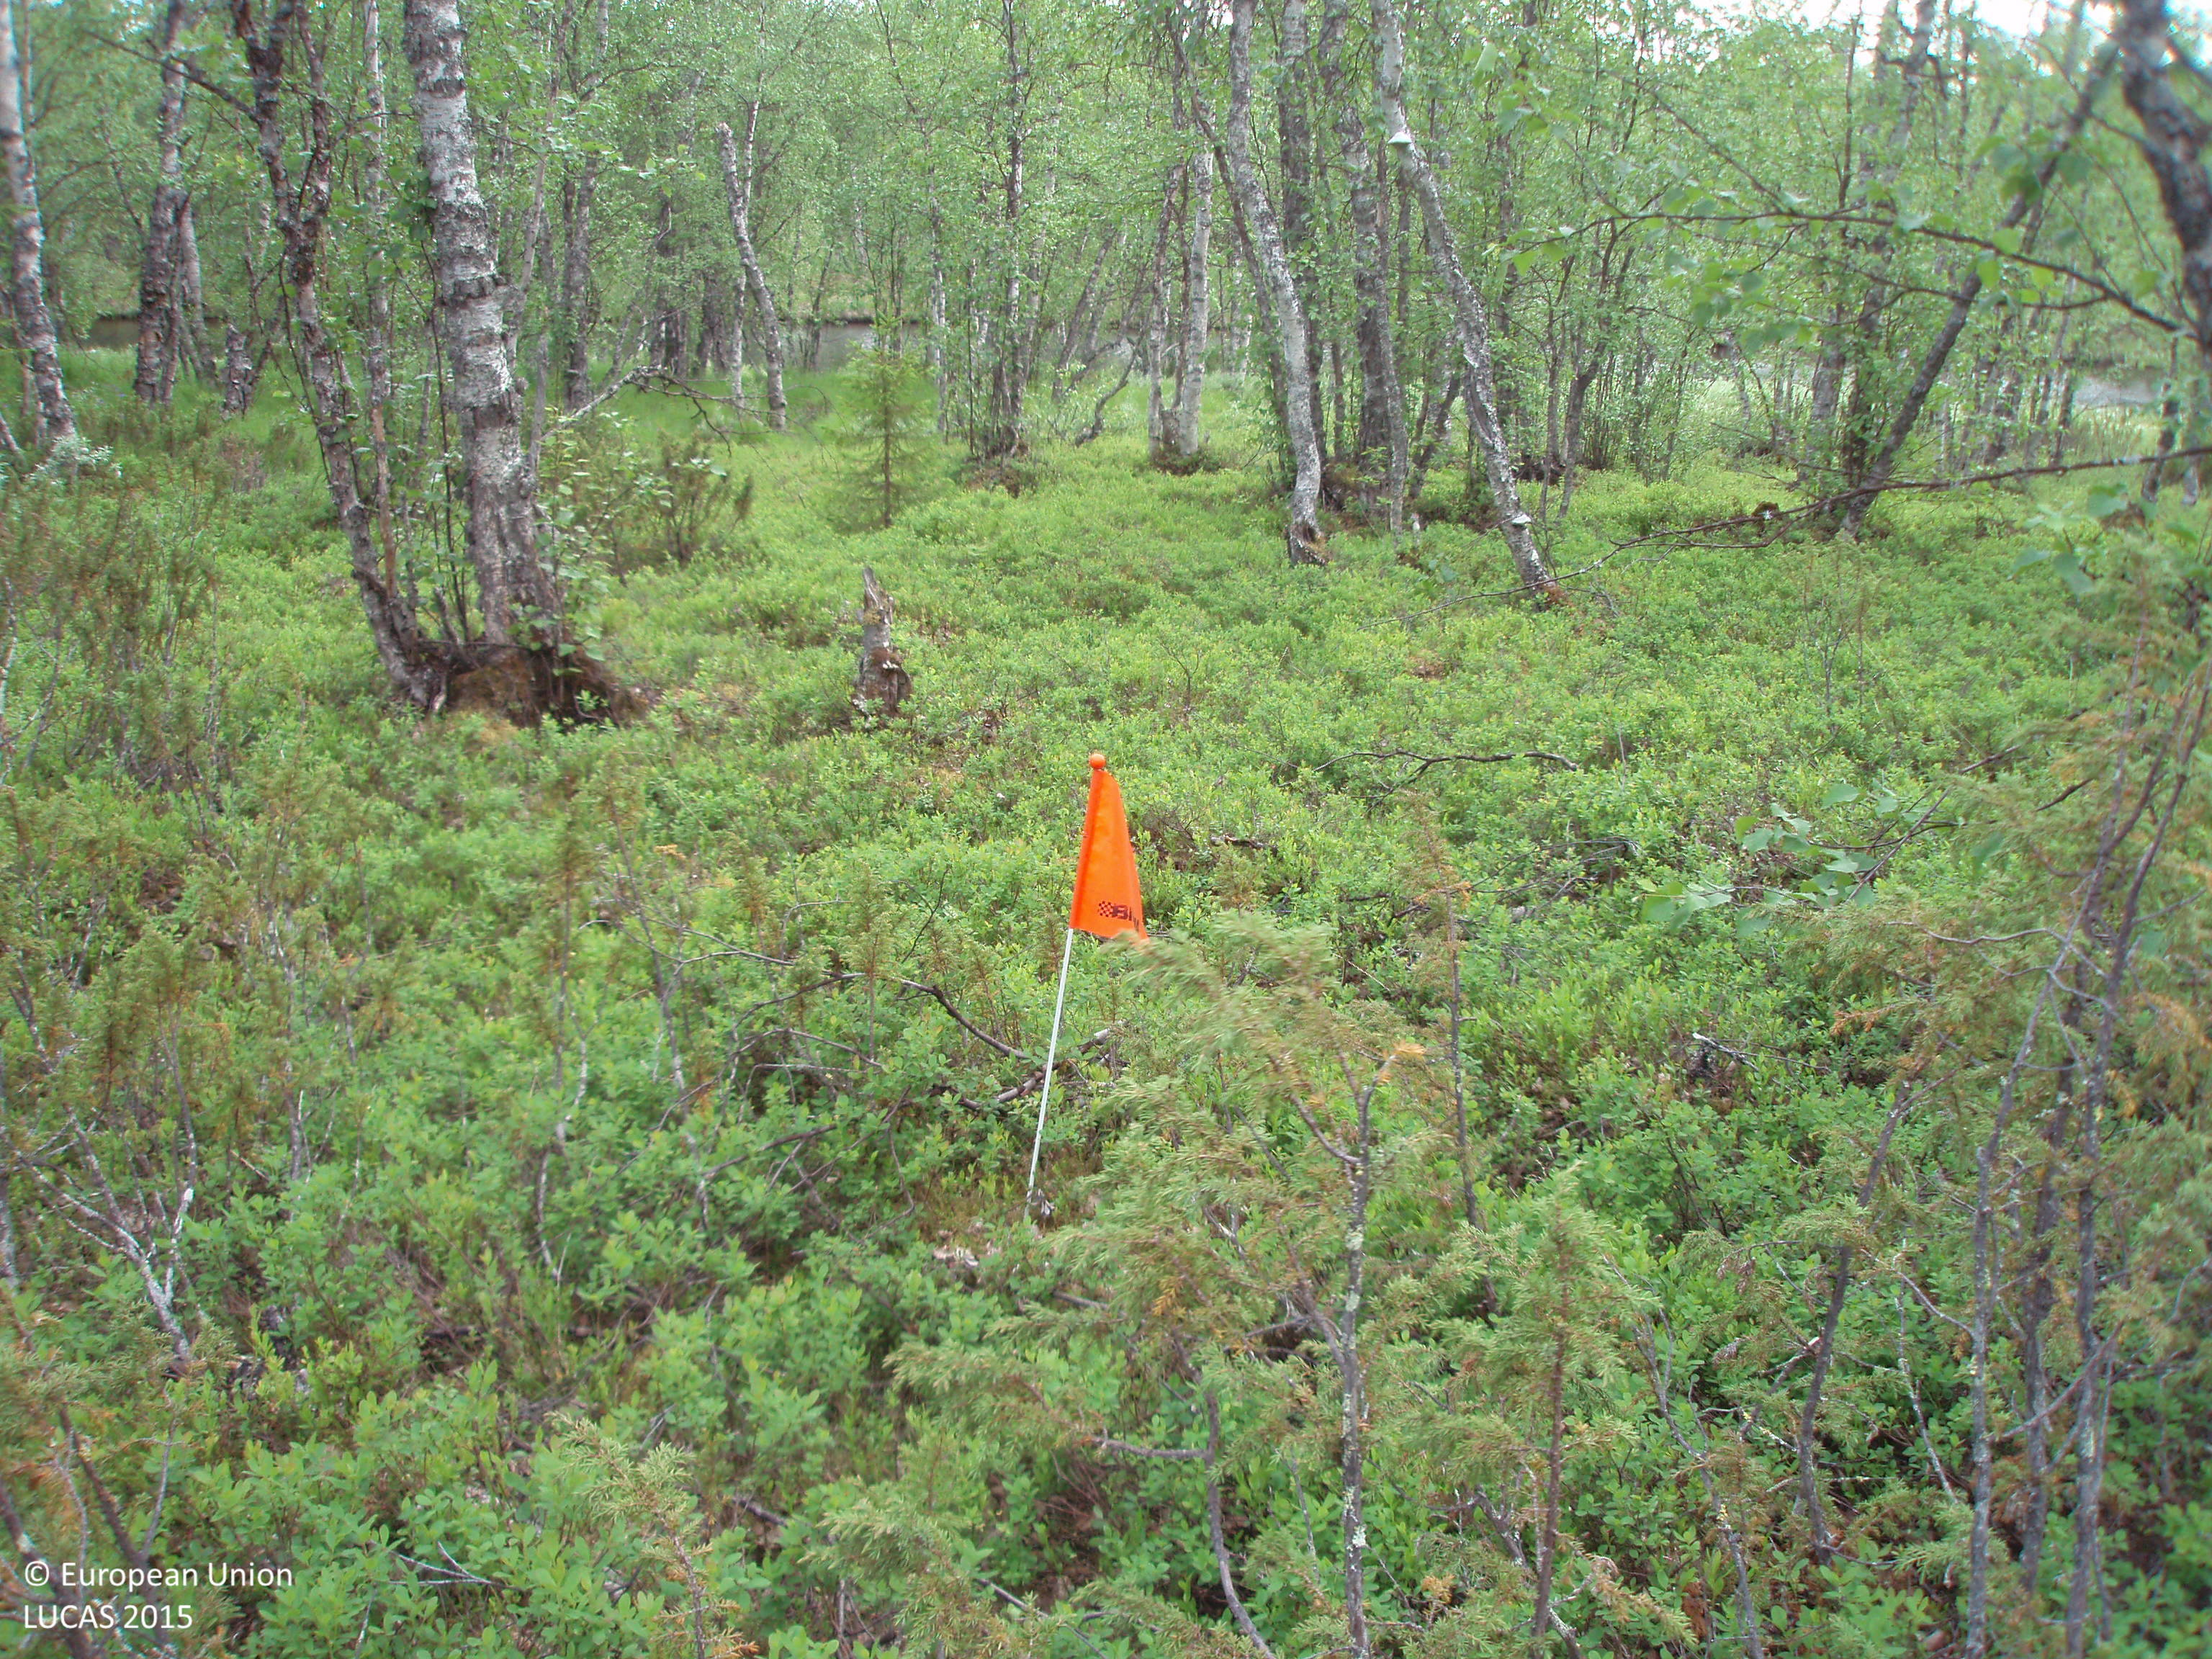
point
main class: Woodland
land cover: Broadleaved woodland
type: non-riverine alder, birch or aspen forest
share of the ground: > 75 %
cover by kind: broadleaved forest trees 70 %, shrubs 25 %, coniferous forest trees 5 %
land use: Forestry
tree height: > 5 m
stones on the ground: 10 - 25 %
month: July
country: FI
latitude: 67.8291
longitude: 29.1658
